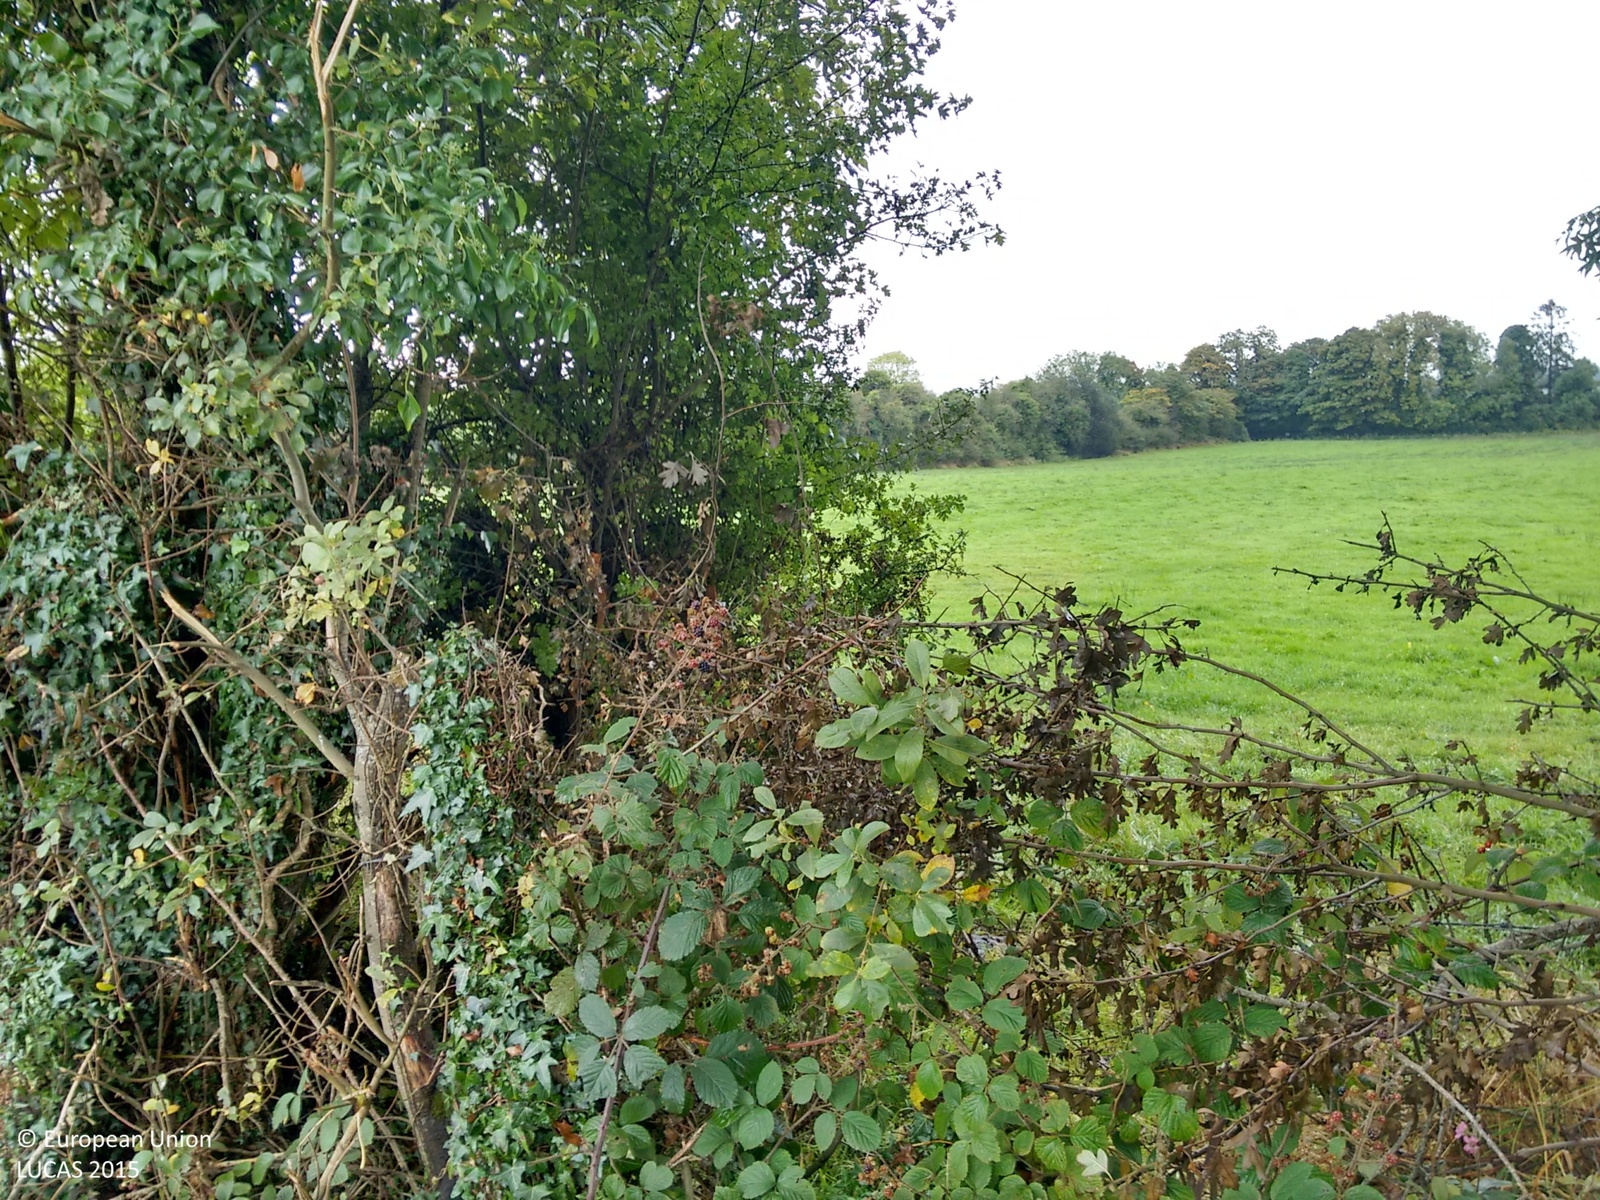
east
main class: Grassland
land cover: Grassland without tree/shrub cover
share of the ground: > 75 %
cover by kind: herbaceous plants 100 %
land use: Agriculture (excluding fallow land and kitchen gardens)
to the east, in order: Grassland without tree/shrub cover; Electric lines; Grassland without tree/shrub cover; Broadleaved woodland; Grassland without tree/shrub cover; Rivers and streams; Broadleaved woodland; Grassland without tree/shrub cover
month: October
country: IE
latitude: 53.7927
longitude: -7.9804
